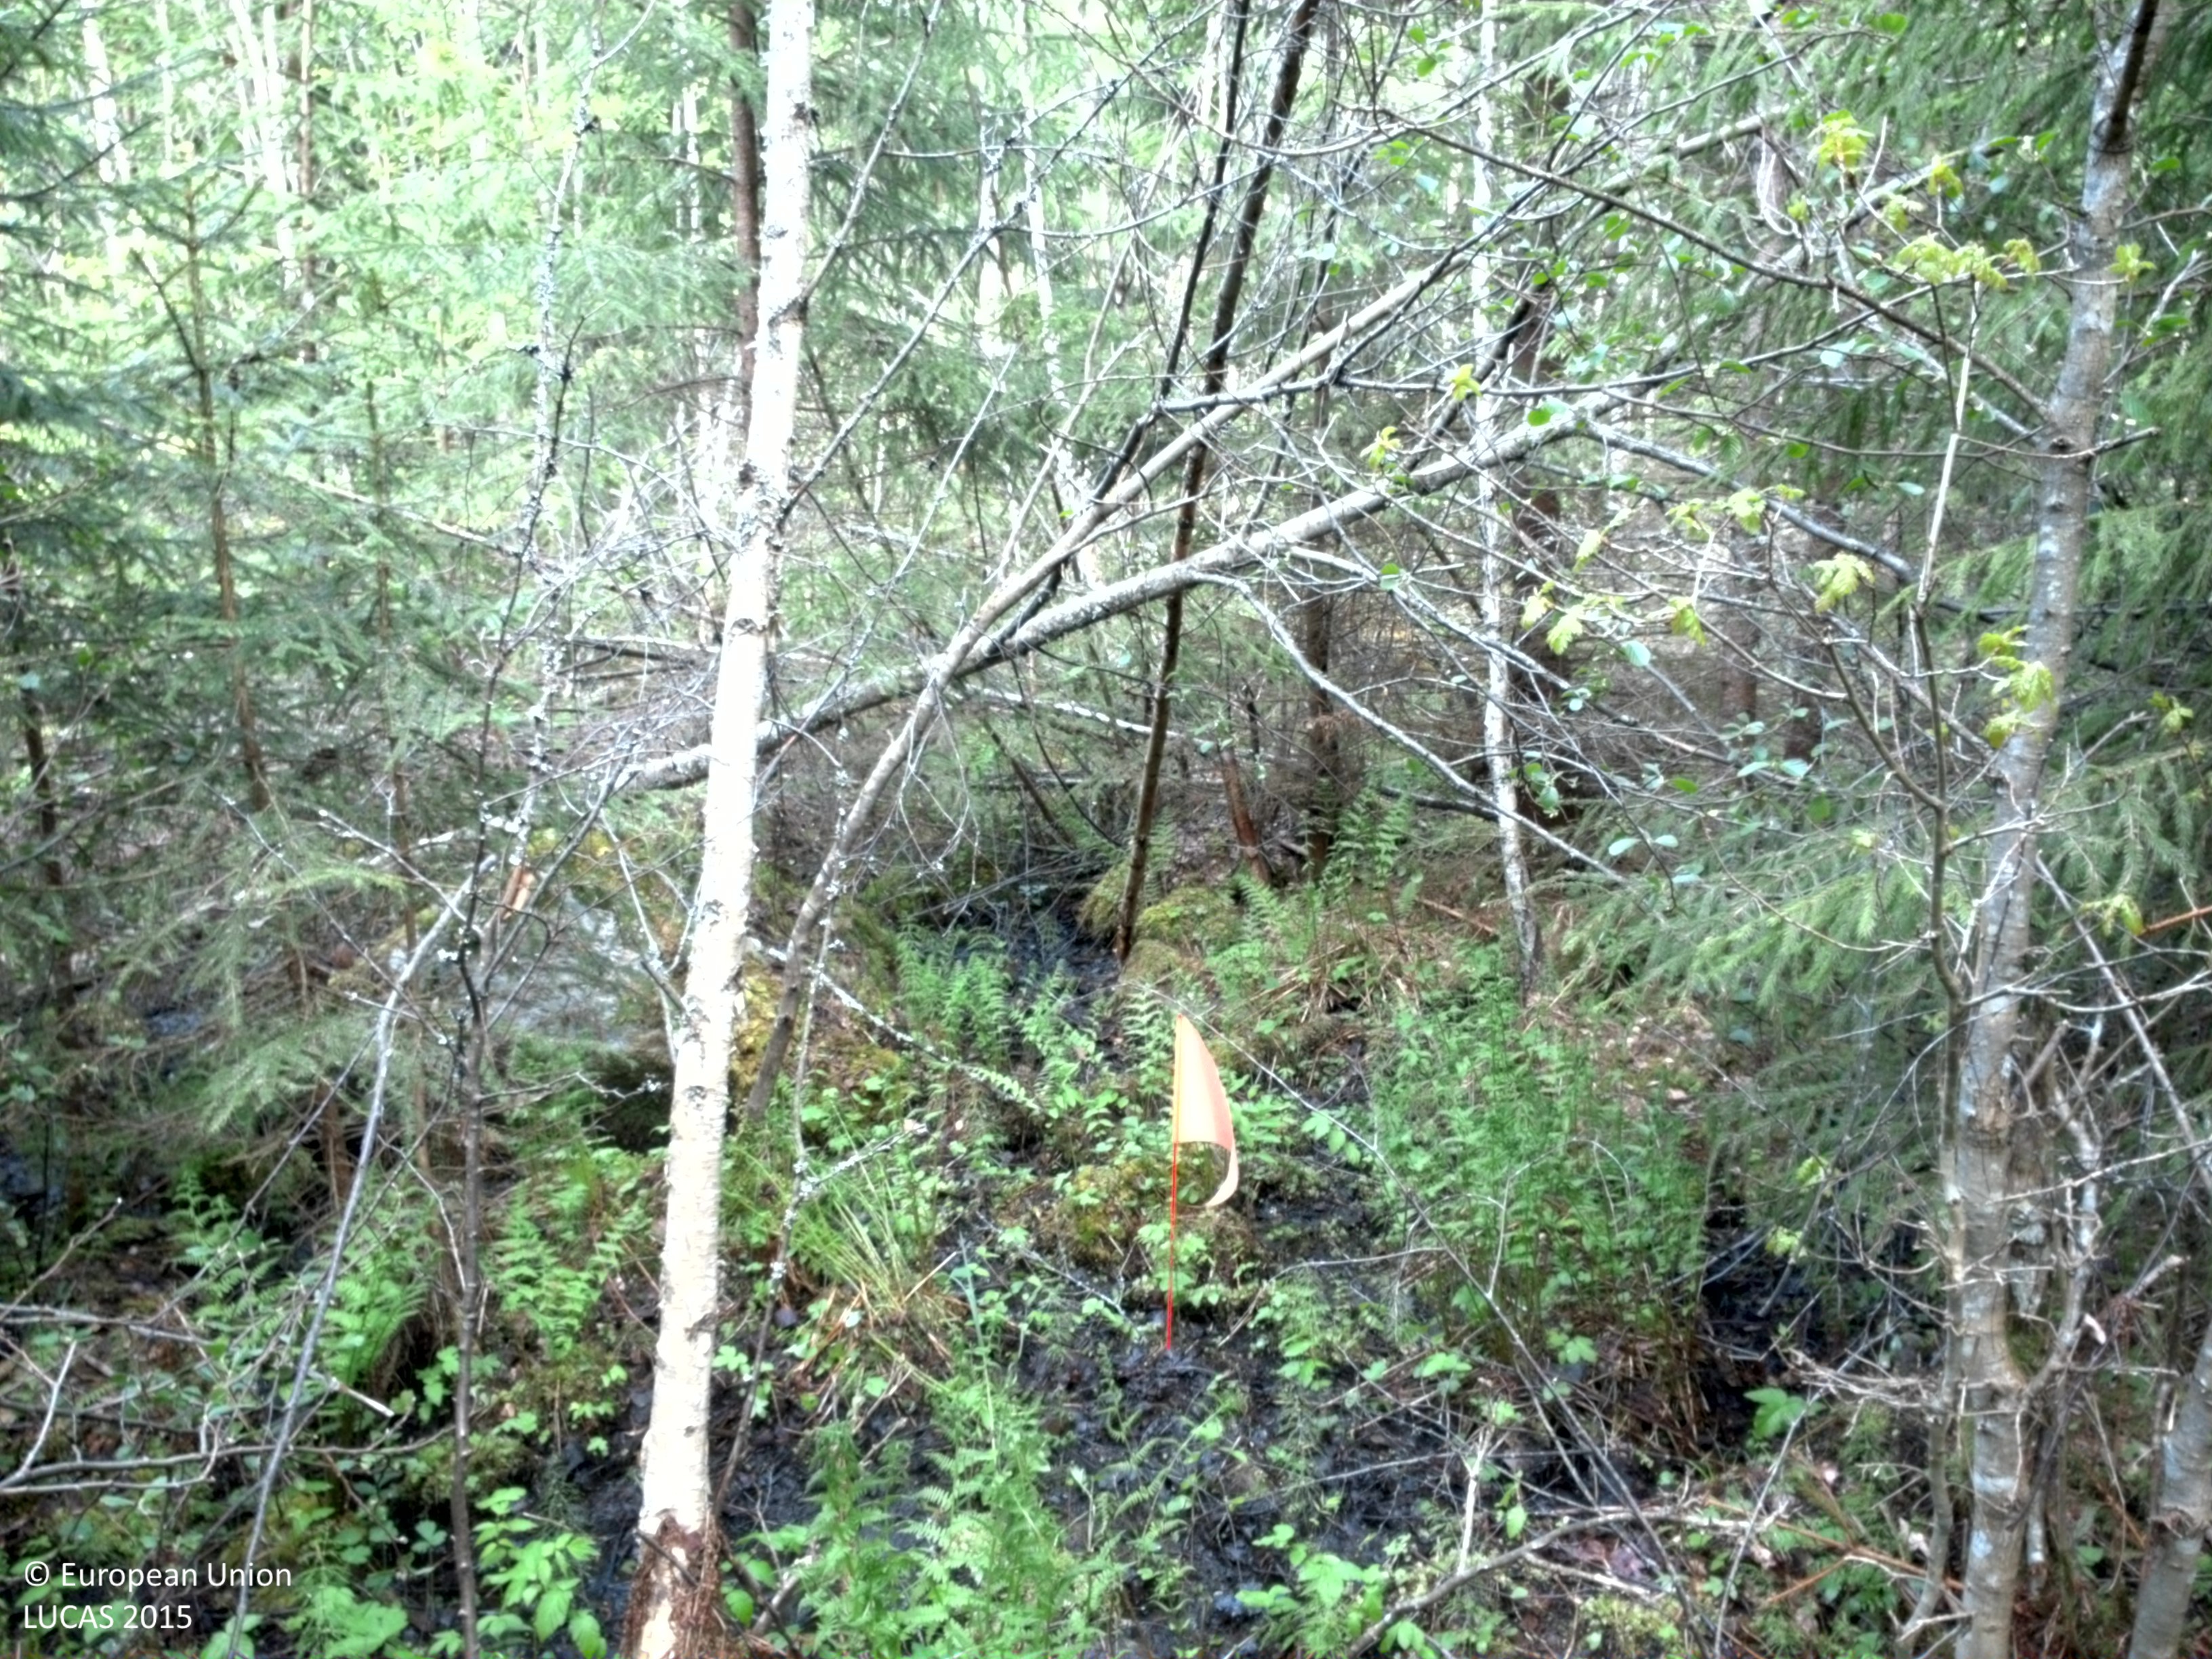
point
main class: Woodland
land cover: Spruce dominated mixed woodland
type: boreal forest
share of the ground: > 75 %
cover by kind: coniferous forest trees 40 %, broadleaved forest trees 35 %, lichens and mosses 15 %, shrubs 5 %, herbaceous plants 5 %
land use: Forestry
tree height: > 5 m
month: May
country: SE
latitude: 57.4077
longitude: 15.4065
